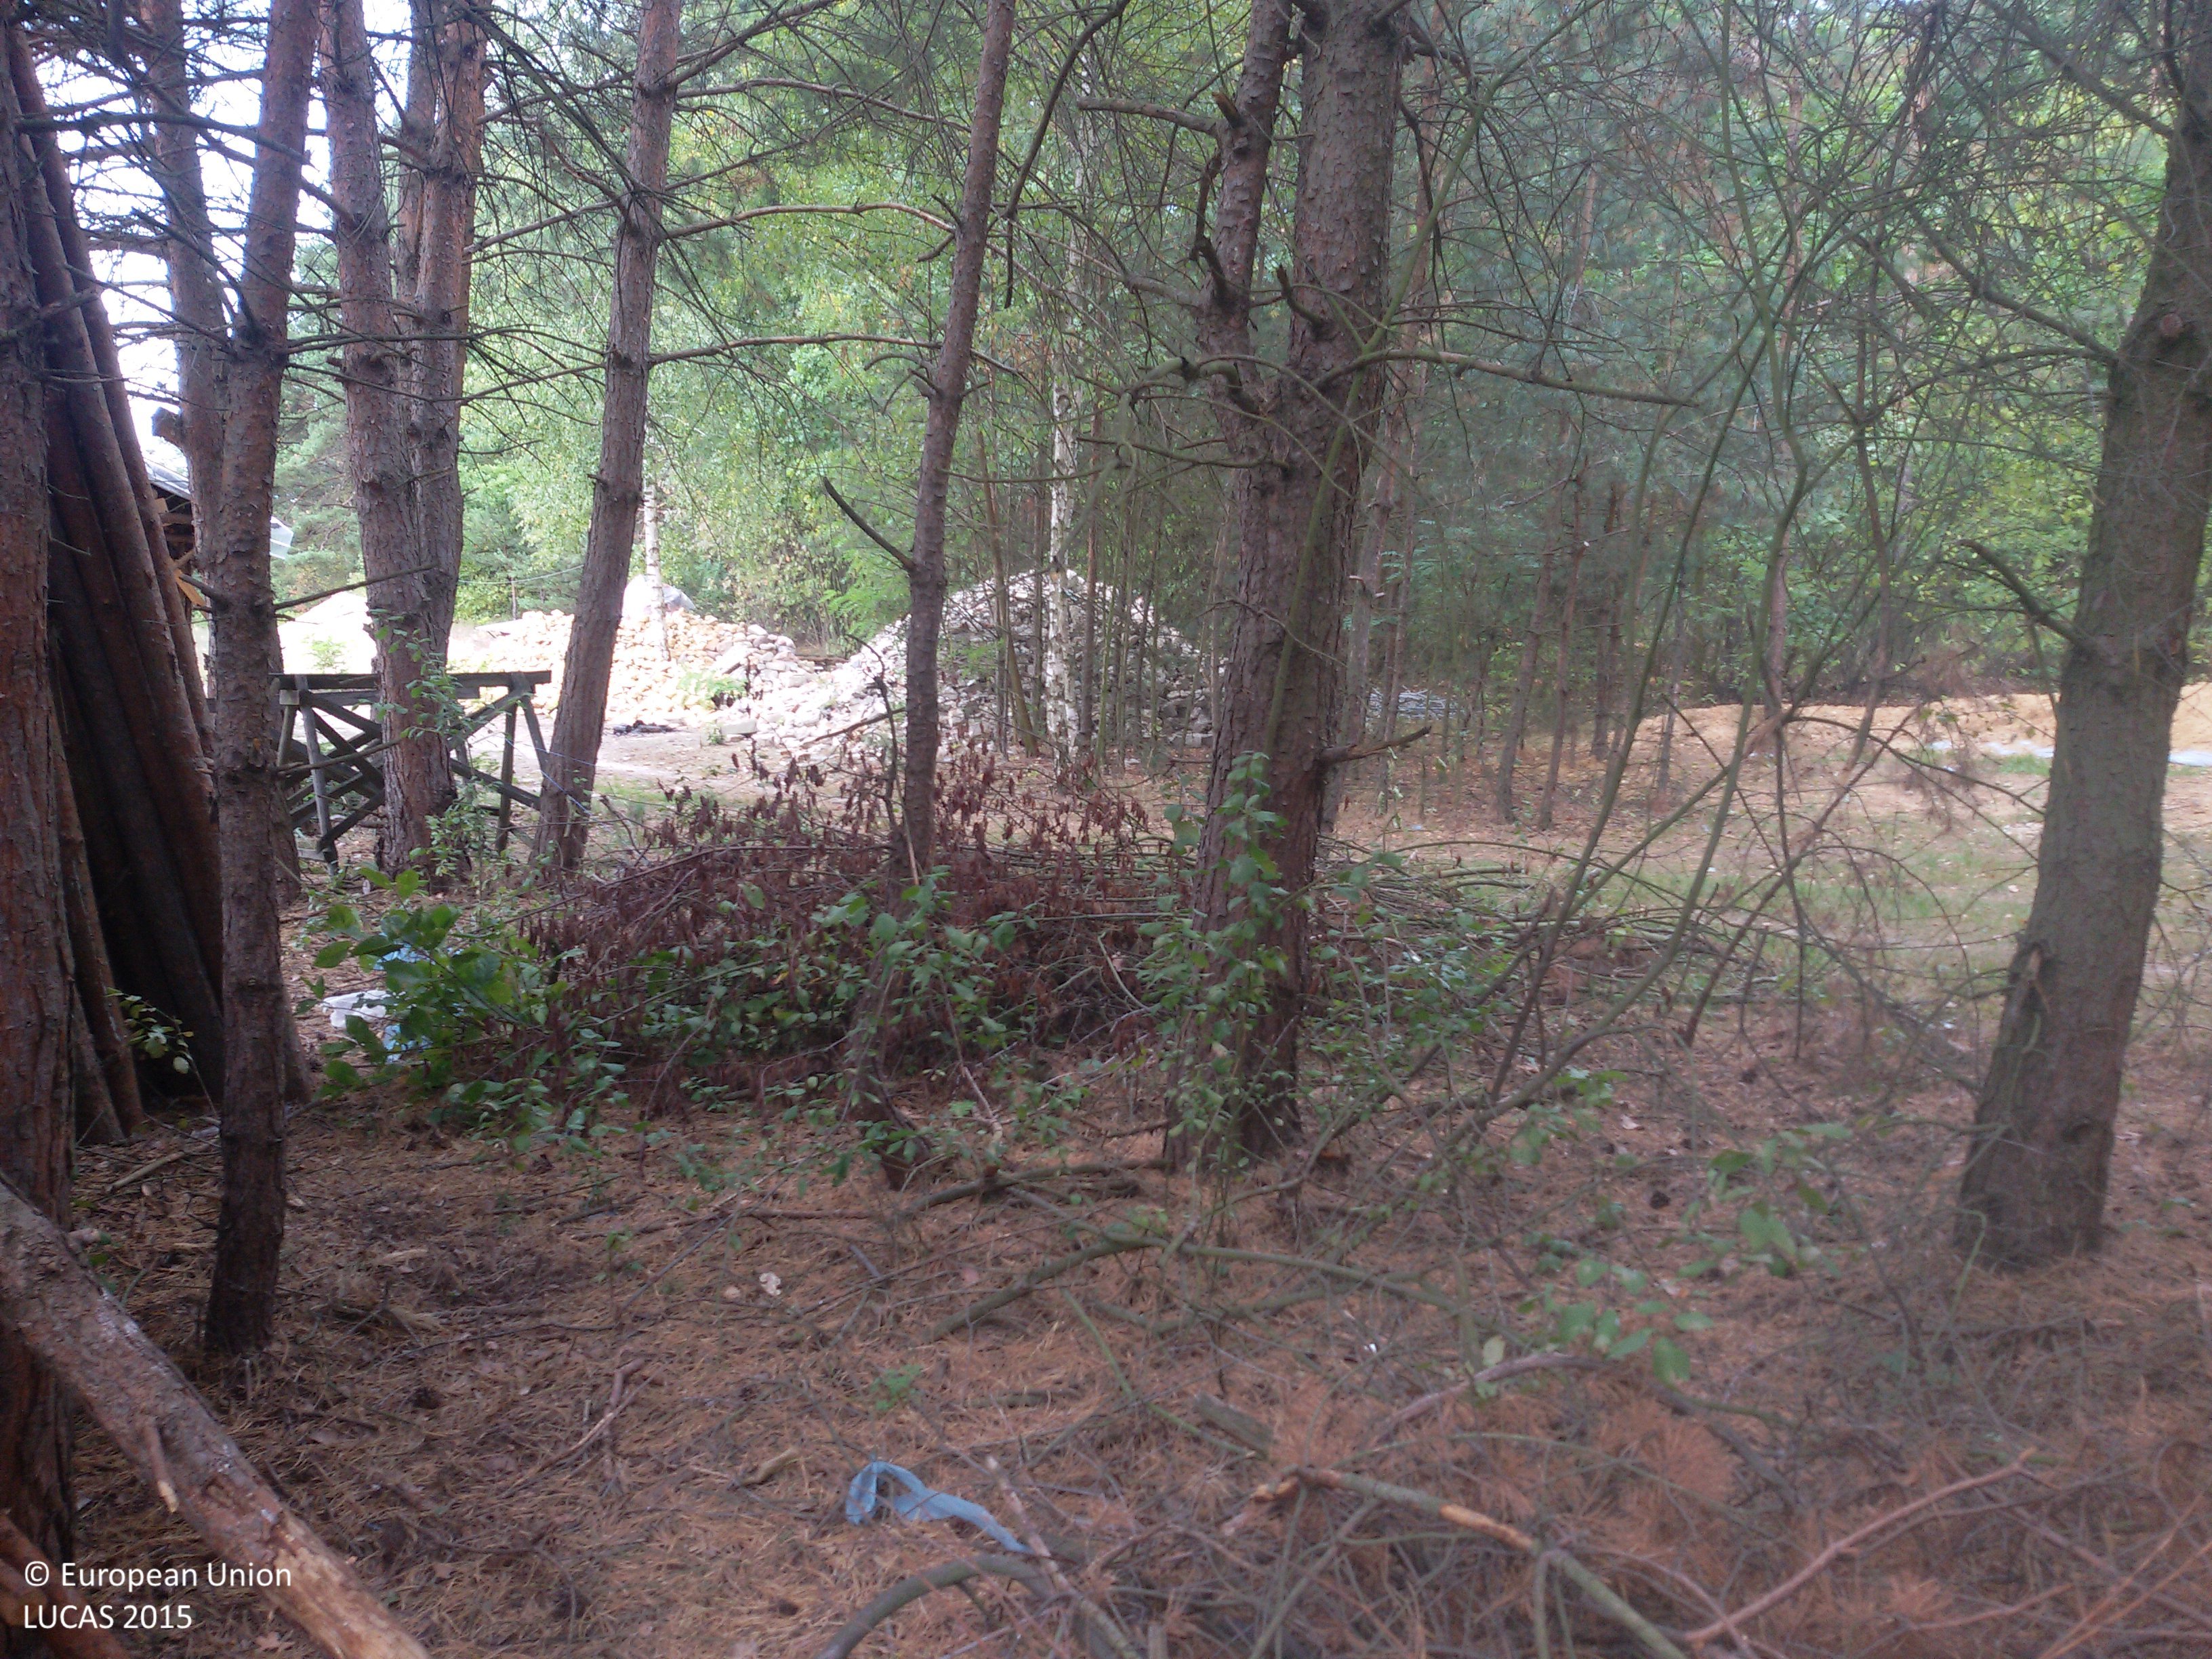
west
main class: Woodland
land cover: Pine dominated coniferous woodland
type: hemiboreal forest and nemoral coniferous forest and mixed broadleaved-coniferous forest
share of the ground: > 75 %
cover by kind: coniferous forest trees 70 %, herbaceous plants 20 %, lichens and mosses 10 %
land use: Forestry
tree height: > 5 m
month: September
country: PL
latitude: 51.0914
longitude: 18.8026
